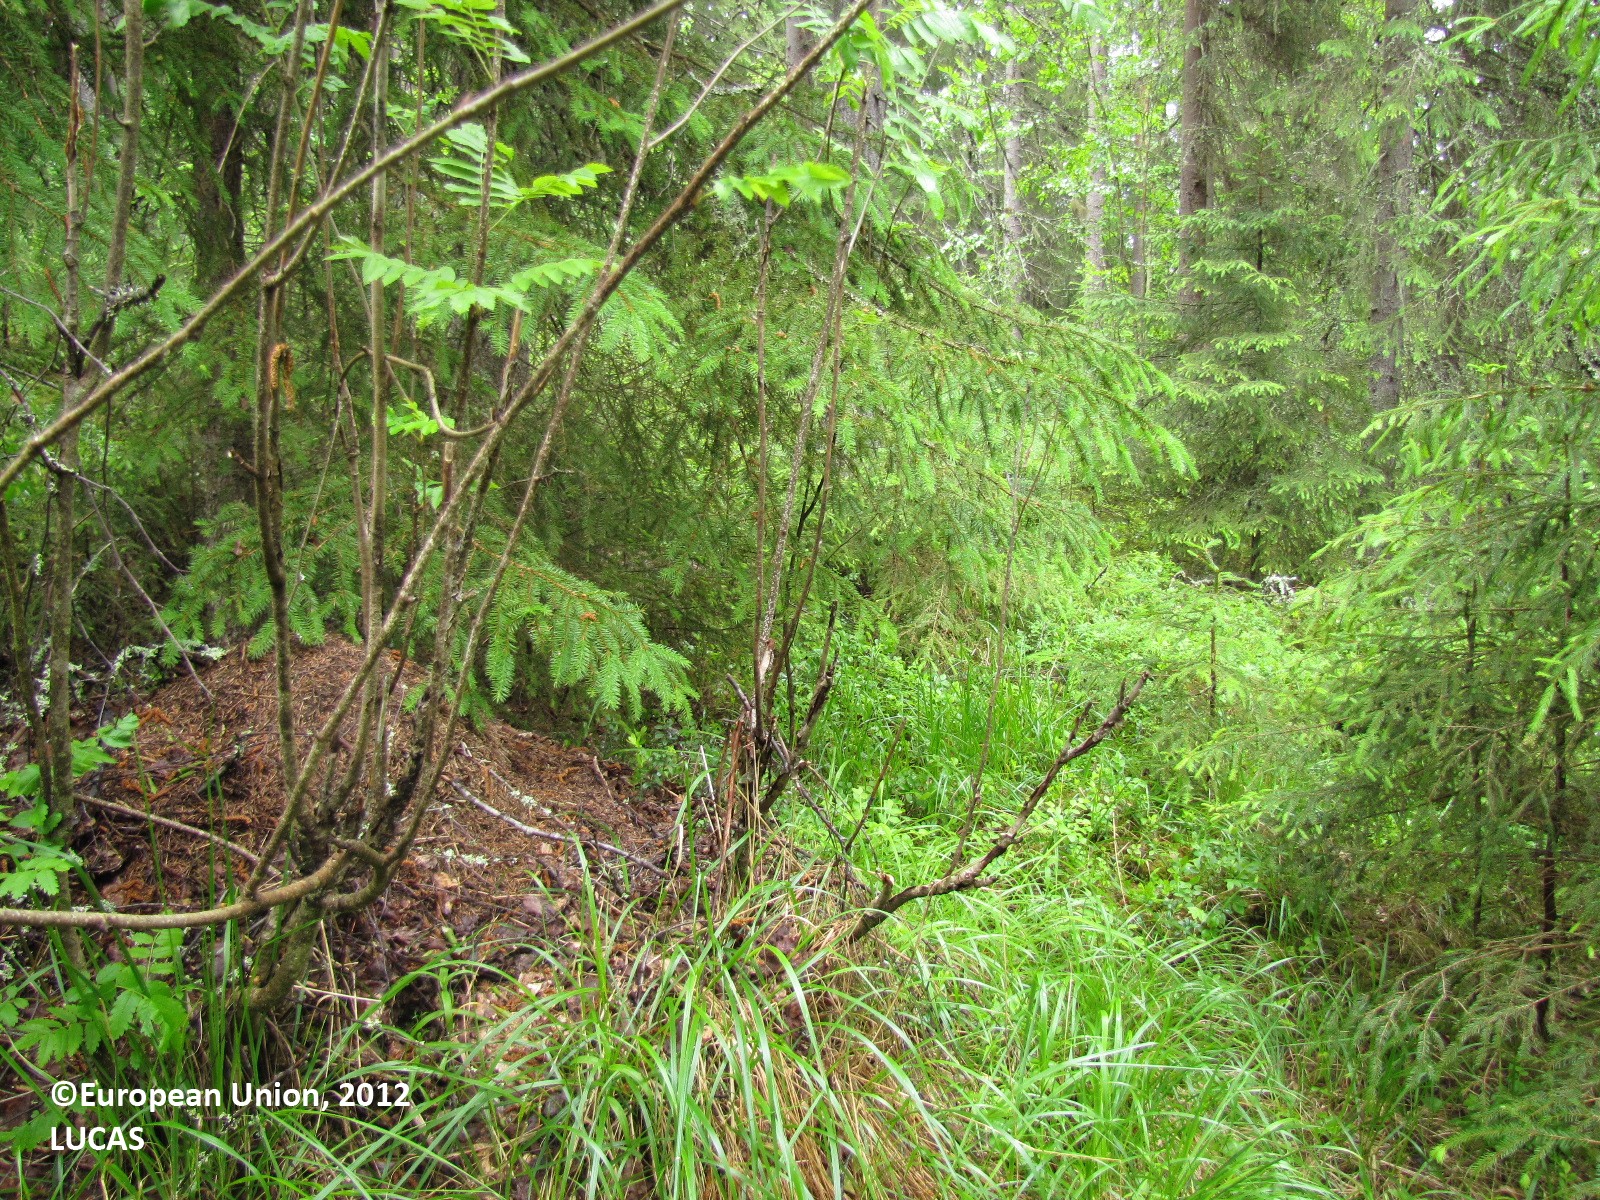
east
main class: Woodland
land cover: Spruce dominated coniferous woodland
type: boreal forest
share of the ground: 50 - 75 %
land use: Forestry
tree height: > 5 m
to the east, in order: Spruce dominated coniferous woodland; Tracks; Spruce dominated coniferous woodland; Spruce dominated mixed woodland
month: June
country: FI
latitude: 61.5516
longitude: 24.7244
